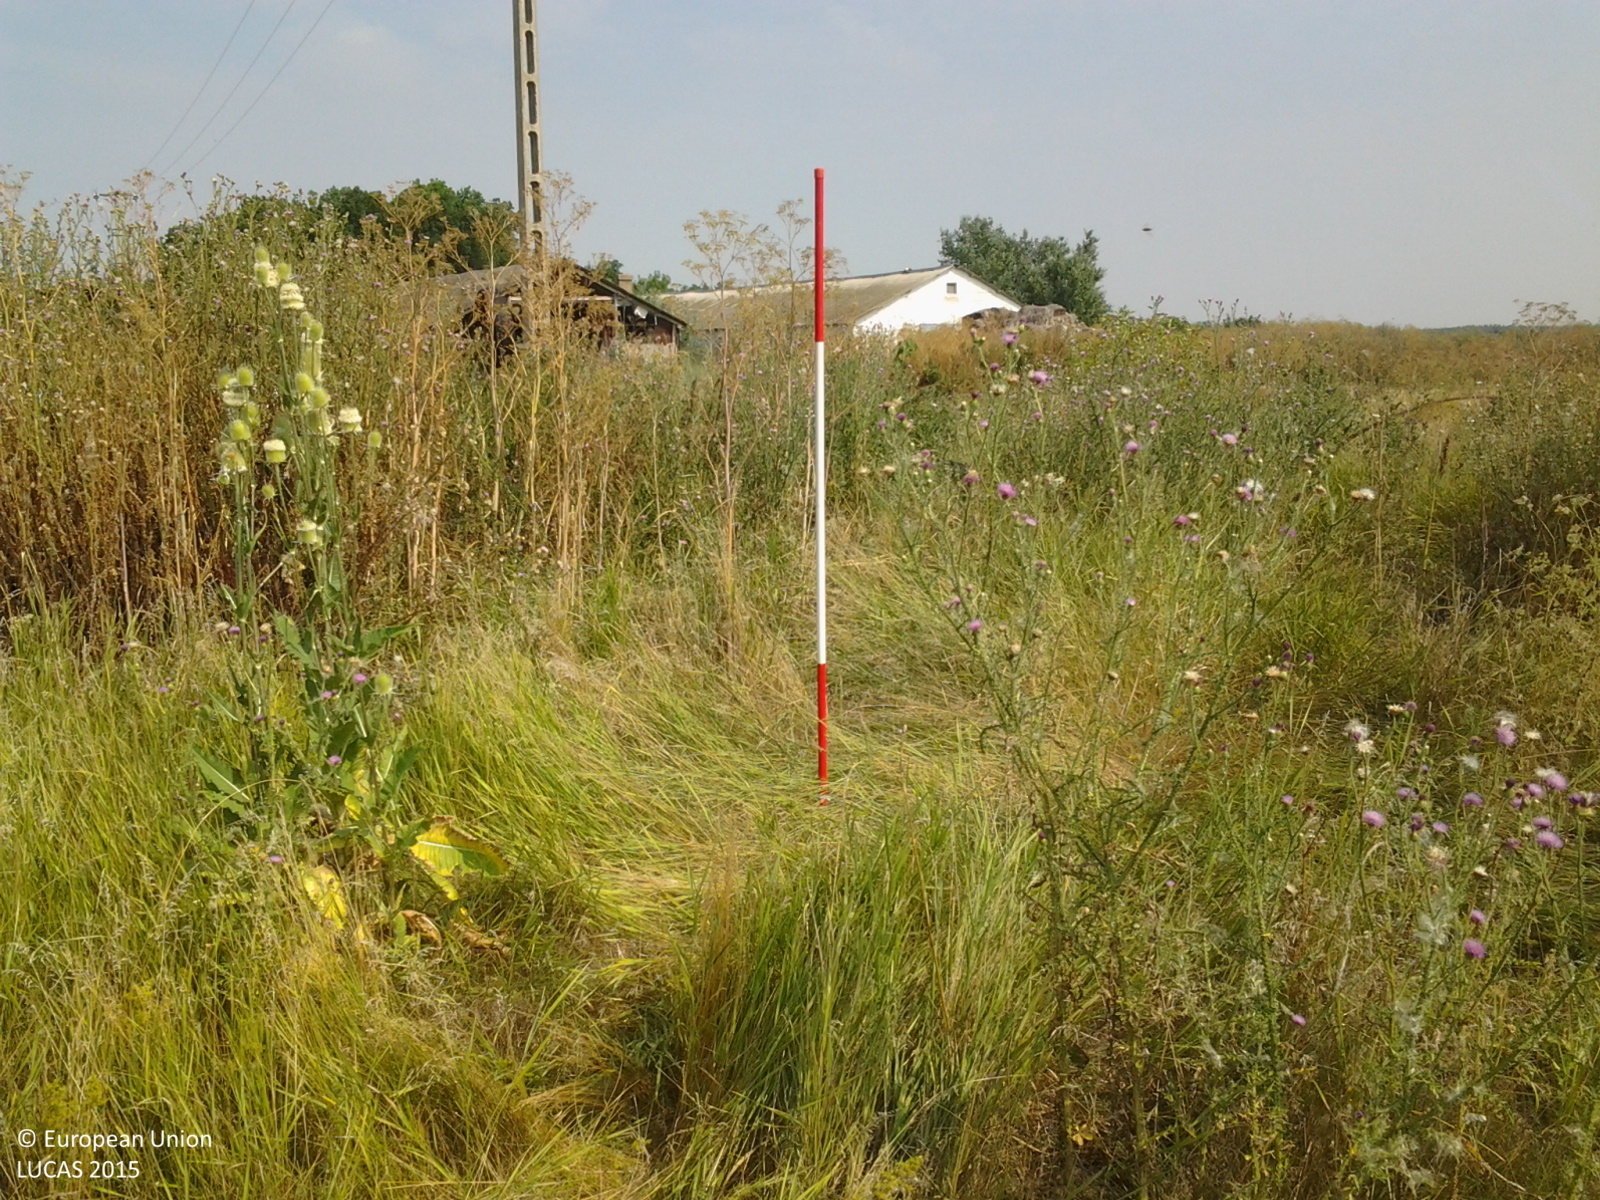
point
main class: Grassland
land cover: Grassland without tree/shrub cover
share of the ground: > 75 %
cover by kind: herbaceous plants 100 %
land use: Agriculture (excluding fallow land and kitchen gardens)
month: July
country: HU
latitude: 46.7916
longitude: 21.4226
